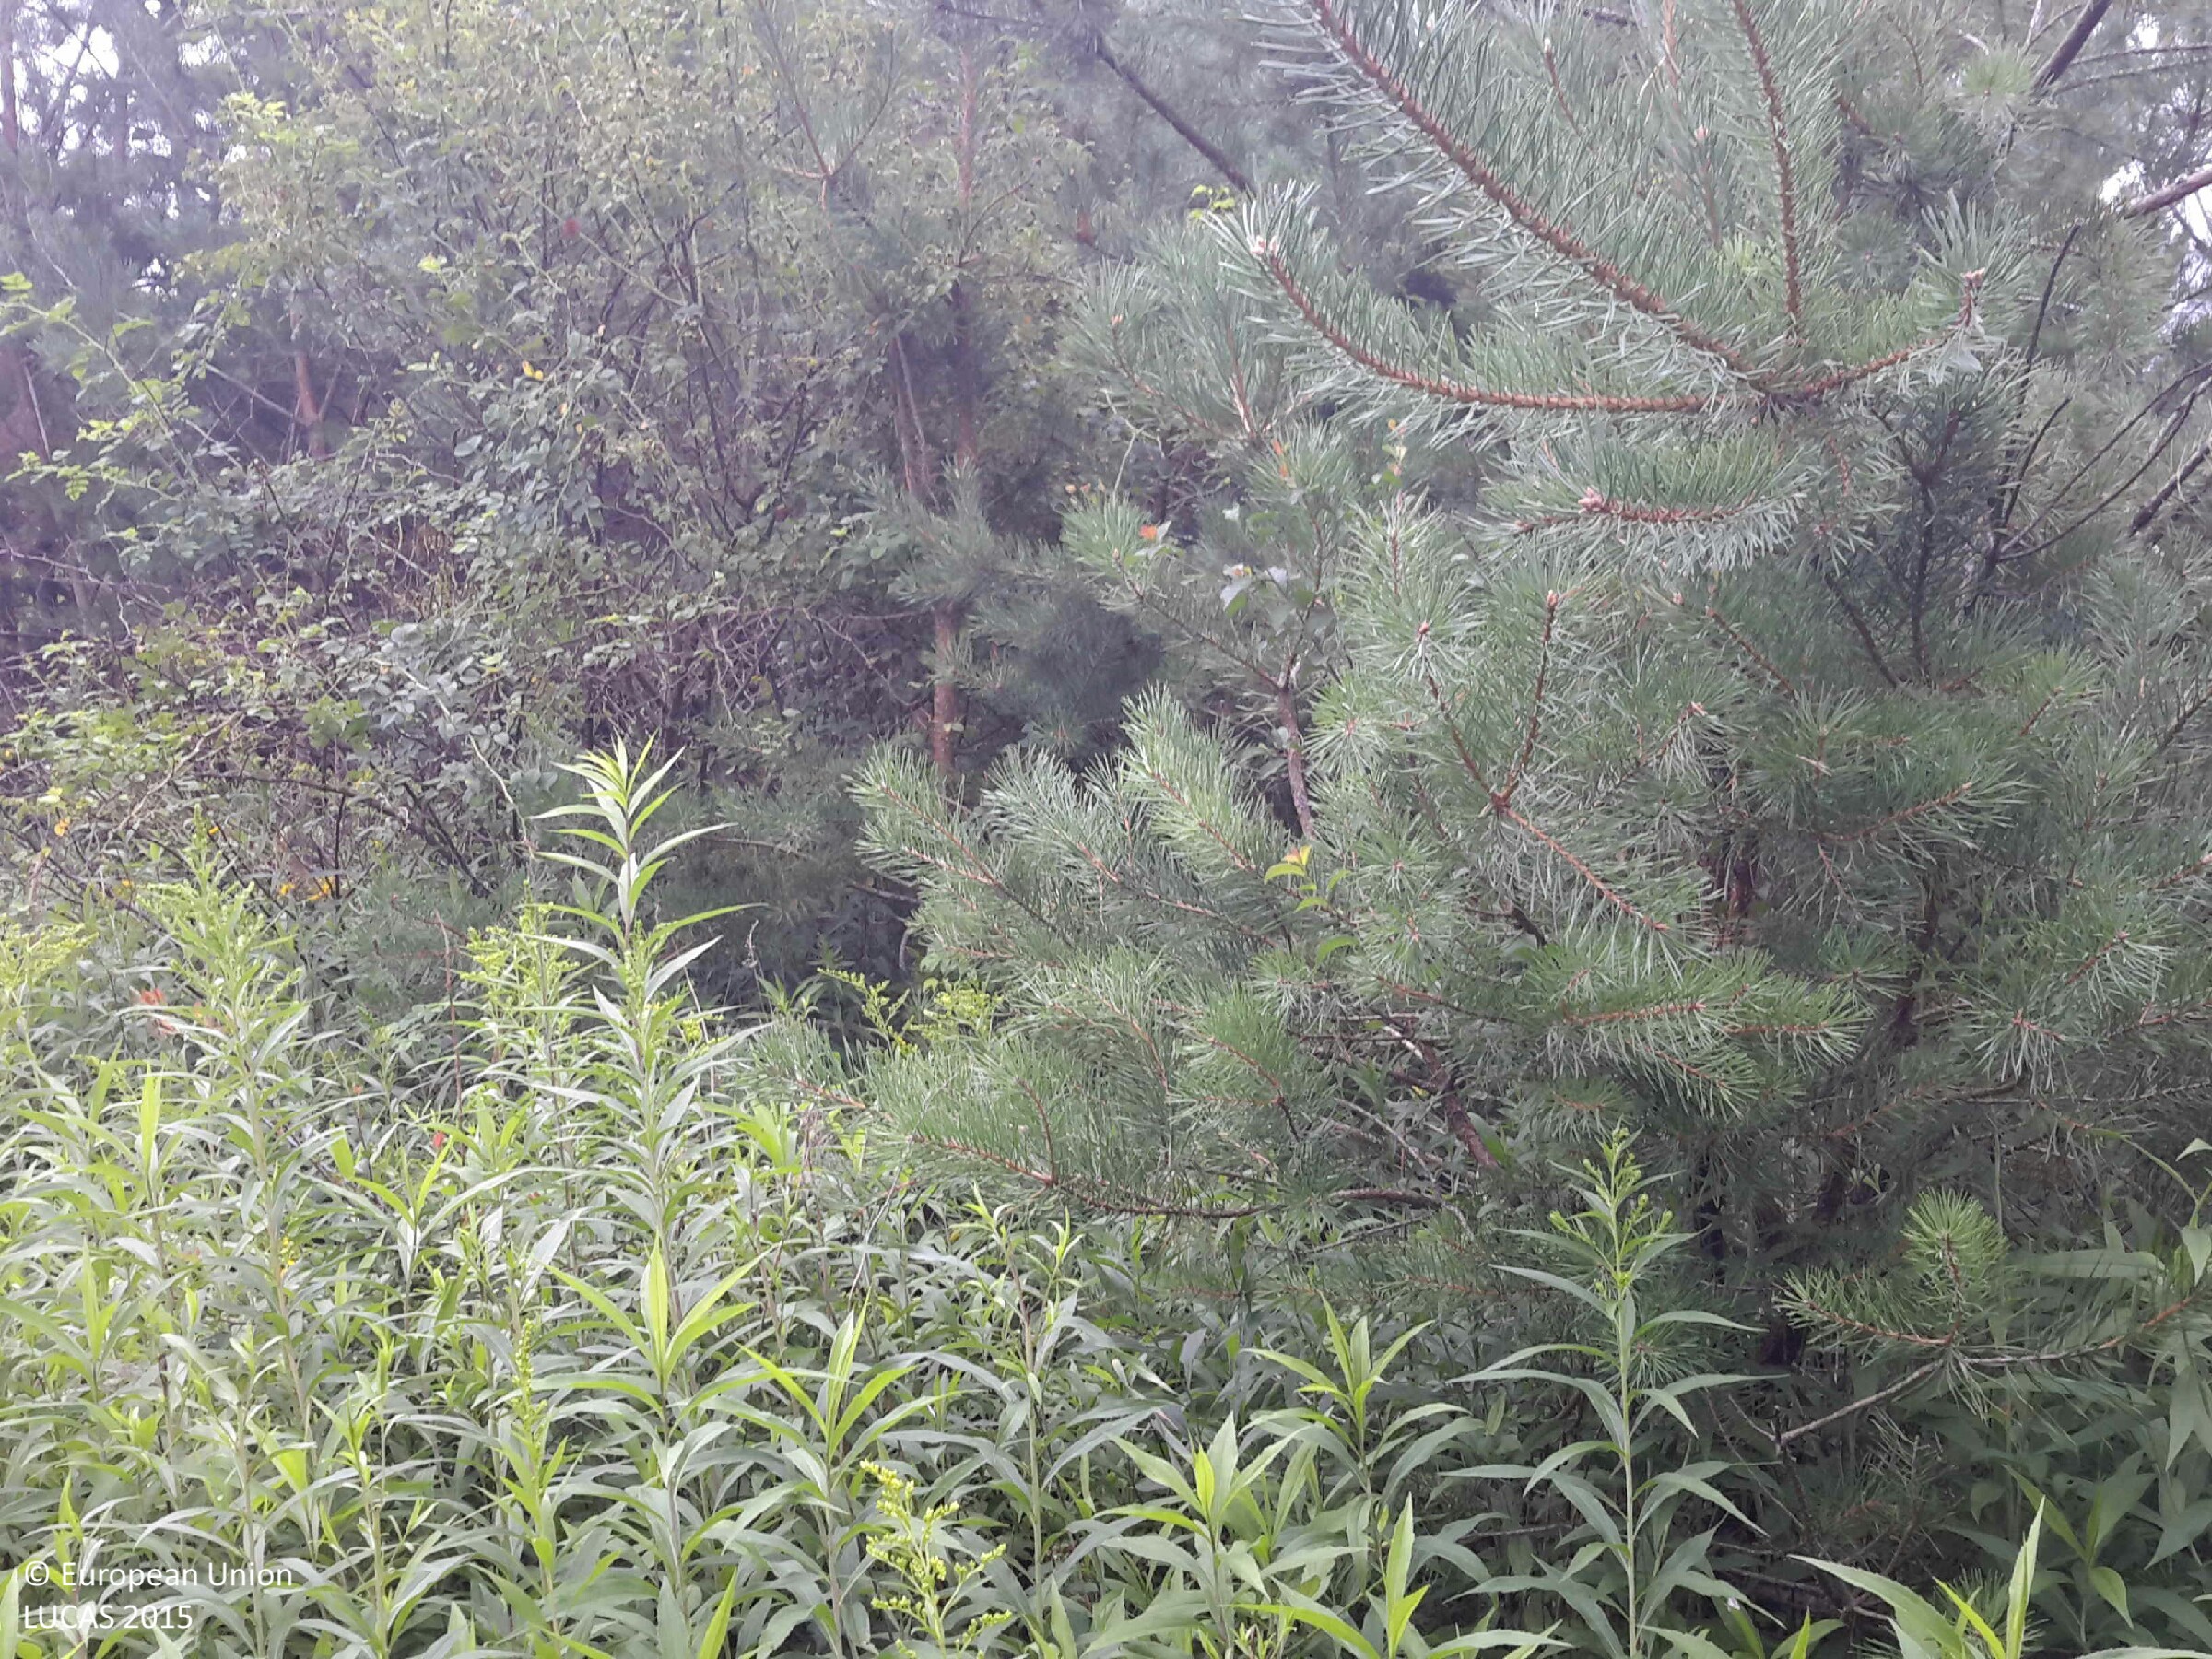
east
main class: Woodland
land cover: Pine dominated coniferous woodland
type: hemiboreal forest and nemoral coniferous forest and mixed broadleaved-coniferous forest
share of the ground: 25 - 50 %
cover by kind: coniferous forest trees 50 %, herbaceous plants 40 %, broadleaved forest trees 10 %
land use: Forestry
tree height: > 5 m
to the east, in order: Pine dominated coniferous woodland; Shrubland with sparse tree cover; Pine dominated coniferous woodland; Tracks; Pine dominated coniferous woodland
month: July
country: HU
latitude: 47.2020
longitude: 16.4846
